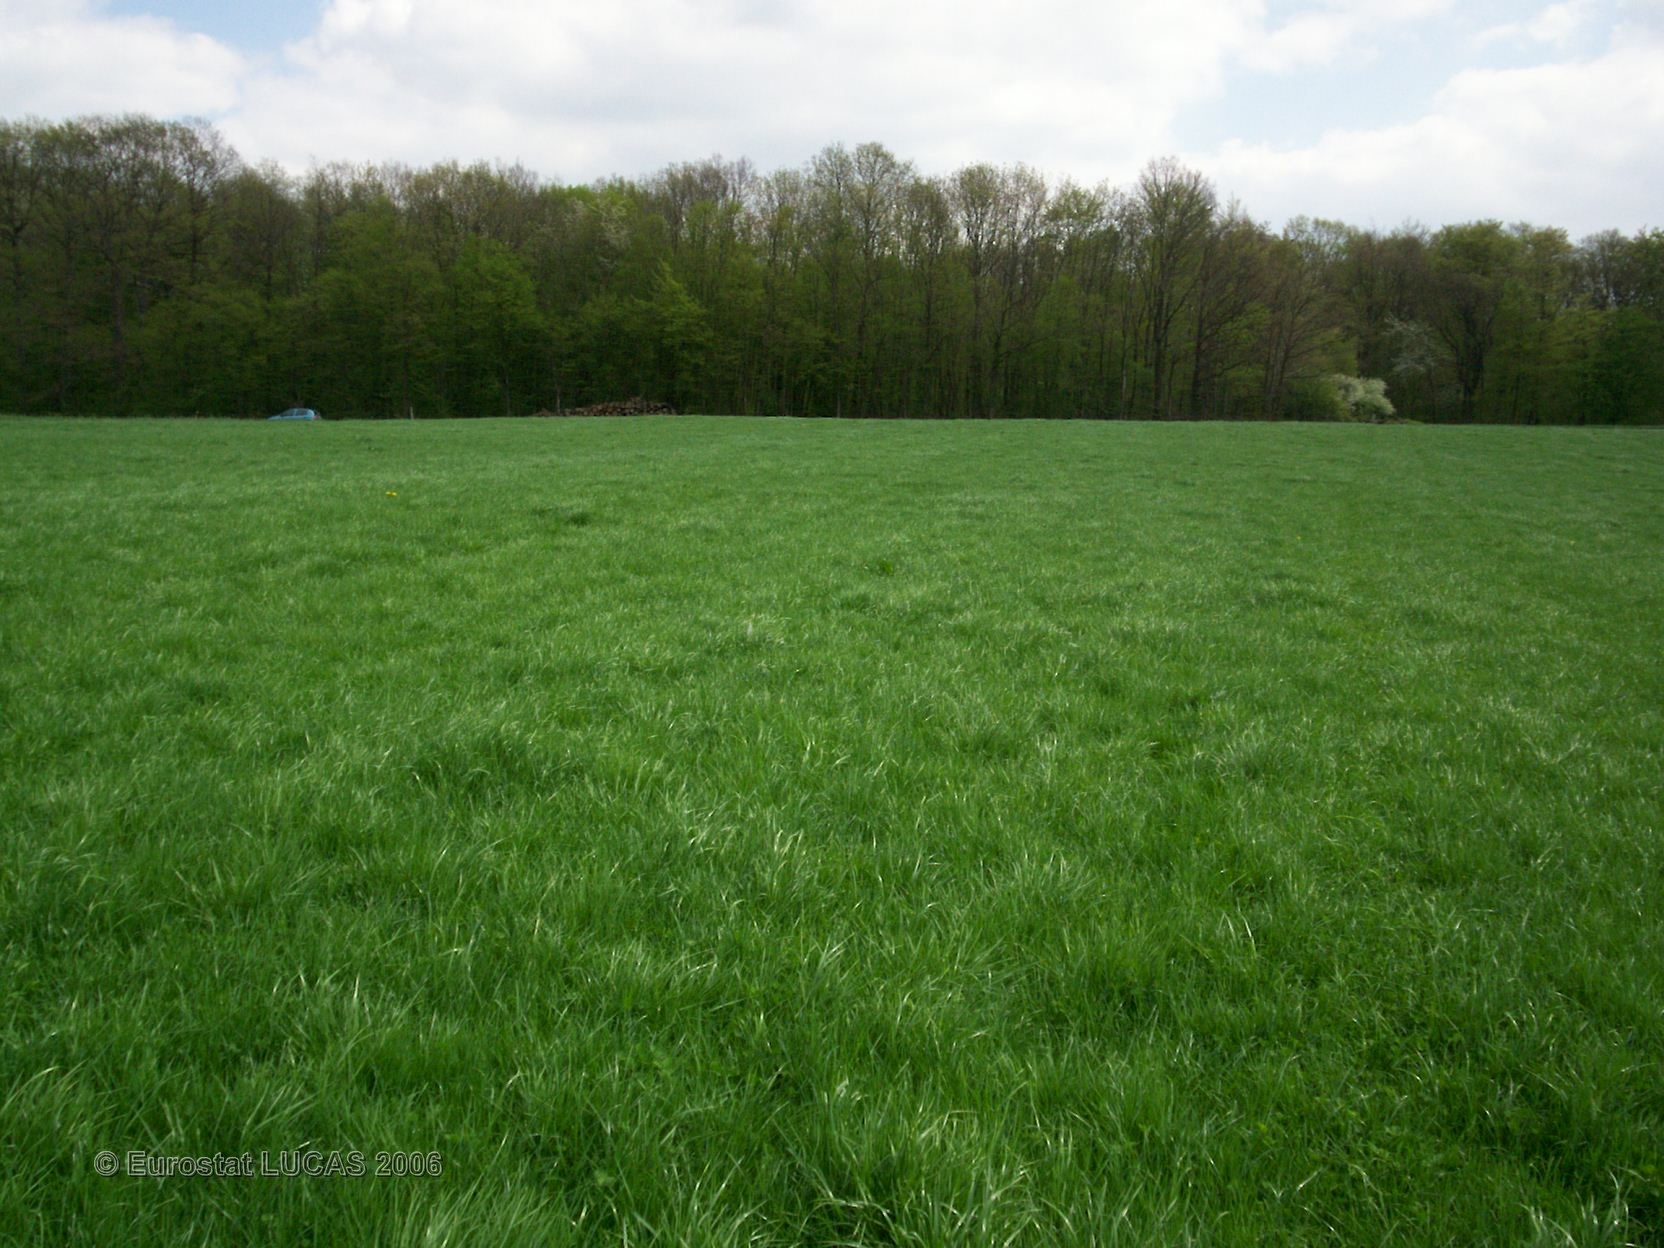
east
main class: Grassland
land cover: Grassland without tree/shrub cover
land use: Agriculture (excluding fallow land and kitchen gardens)
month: April
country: FR
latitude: 48.9863
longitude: 6.7617
